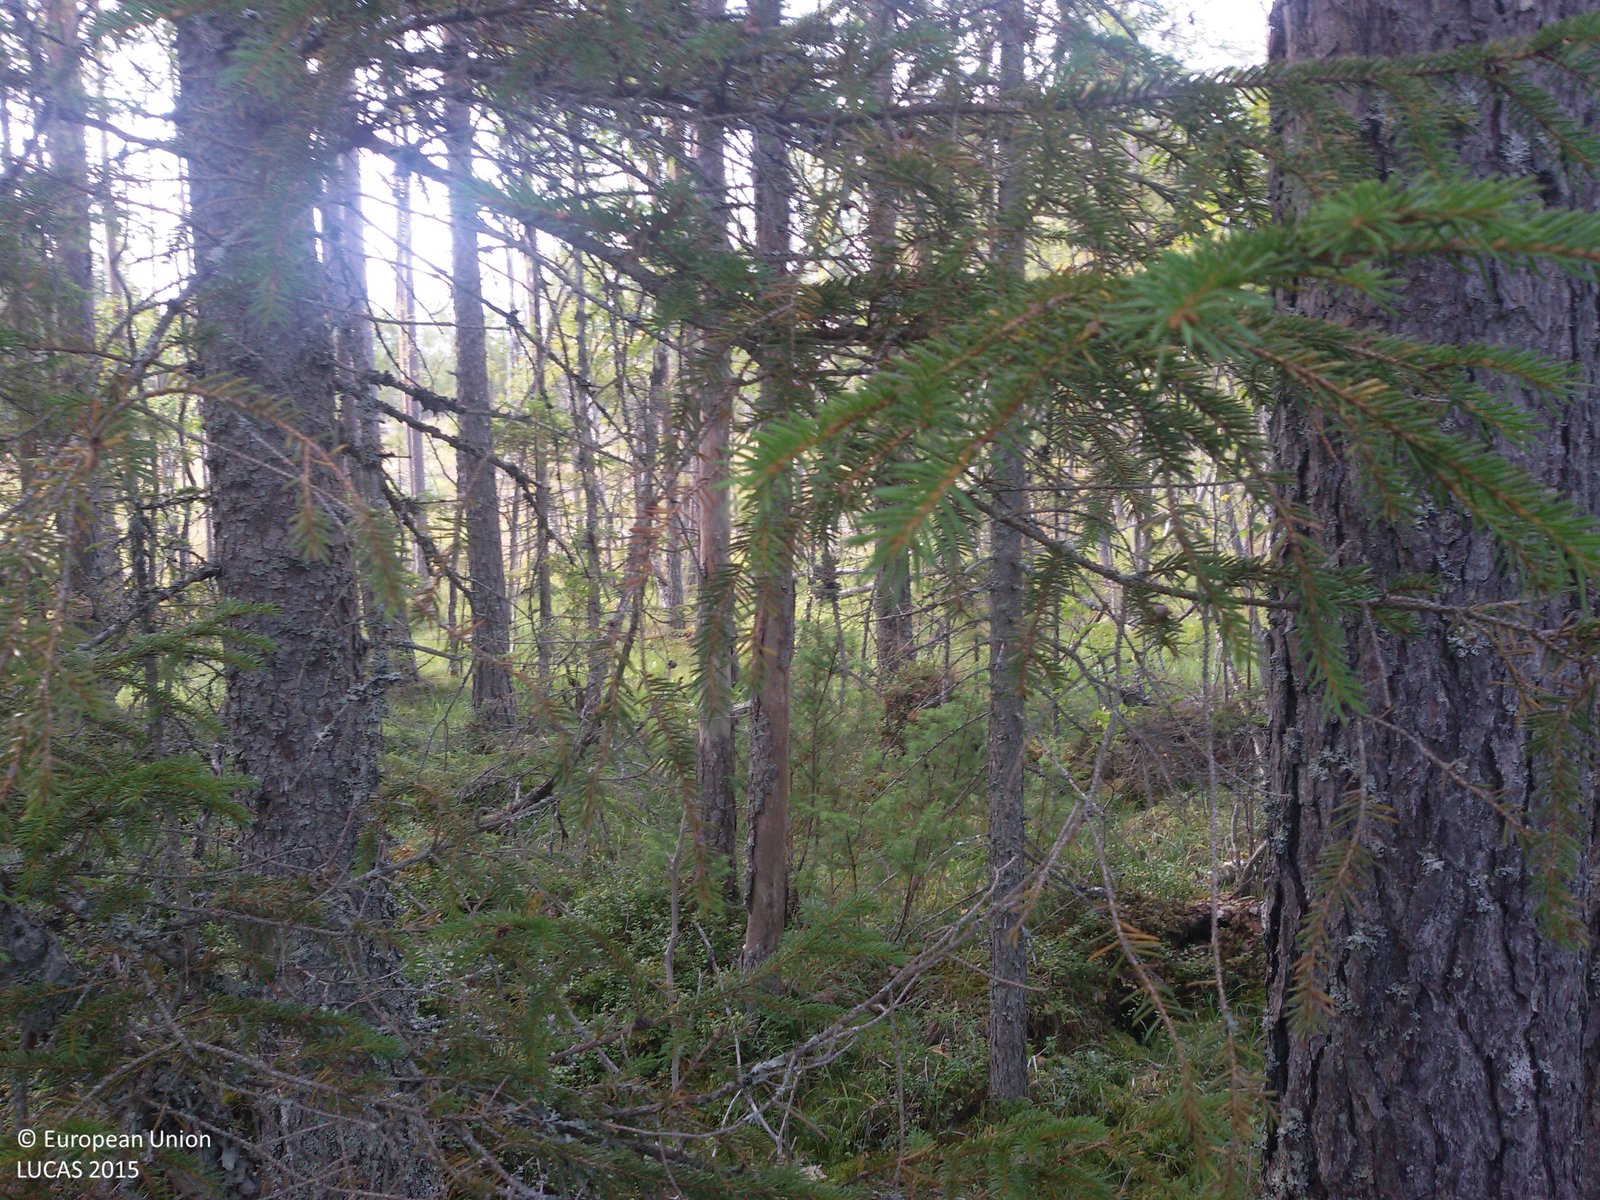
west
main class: Woodland
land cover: Pine dominated mixed woodland
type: boreal forest
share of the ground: 50 - 75 %
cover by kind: coniferous forest trees 45 %, broadleaved forest trees 25 %, herbaceous plants 15 %, lichens and mosses 15 %
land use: Forestry
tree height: > 5 m
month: September
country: SE
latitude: 60.8695
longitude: 15.4557
